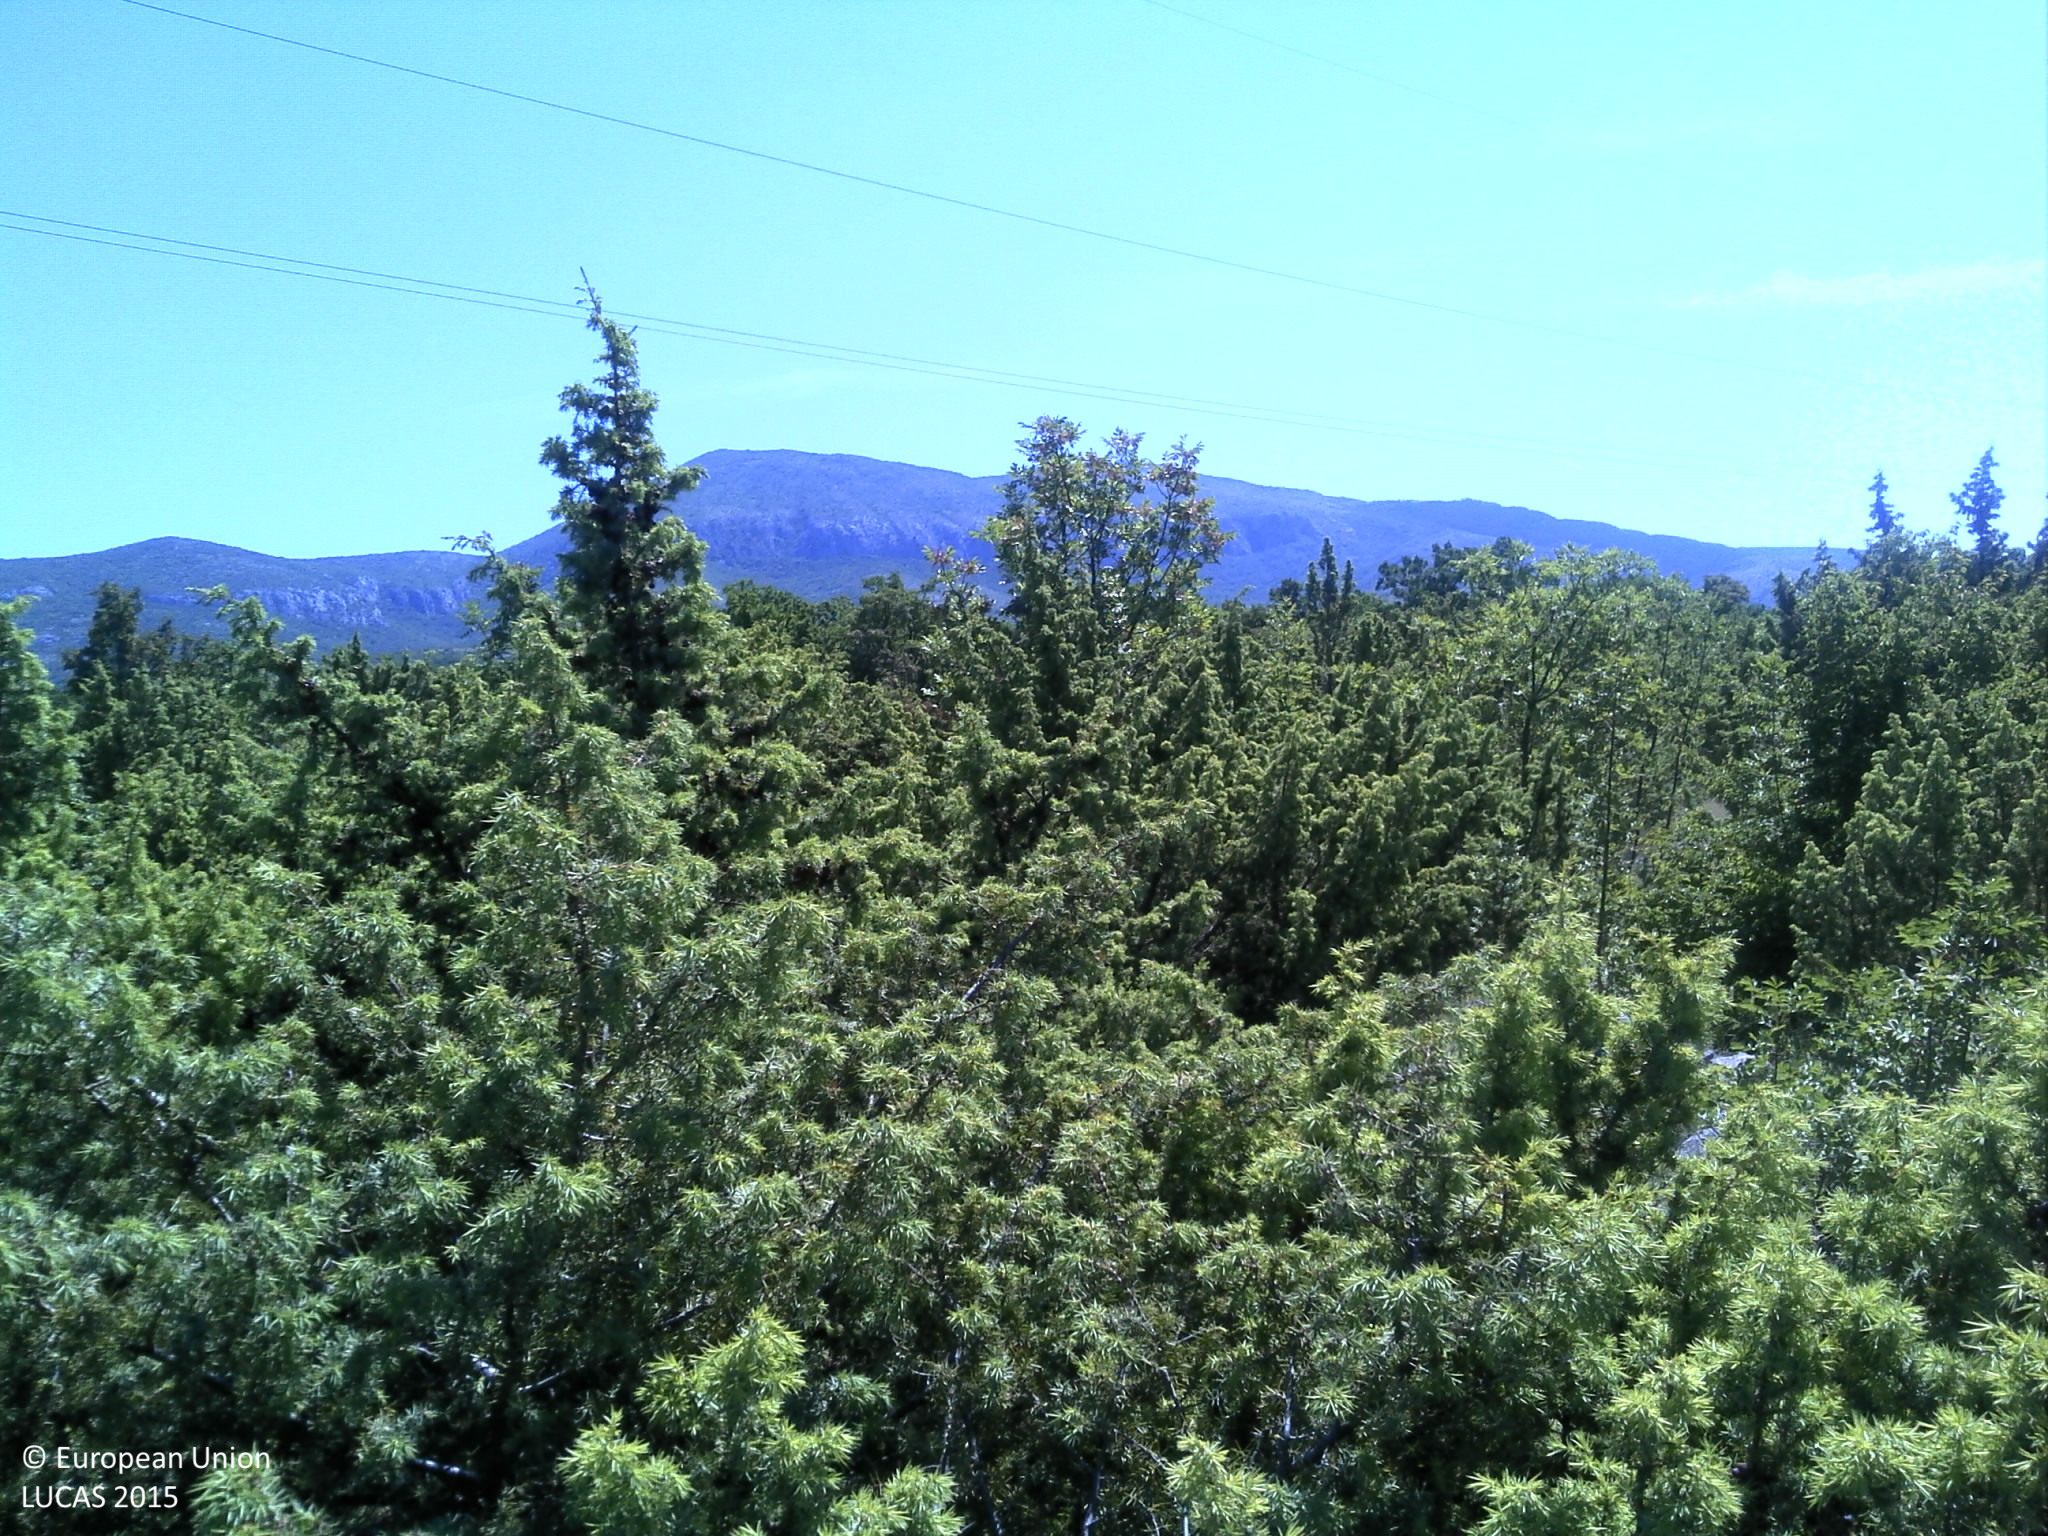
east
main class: Shrubland
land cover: Shrubland with sparse tree cover
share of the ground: 50 - 75 %
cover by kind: shrubs 50 %, herbaceous plants 35 %, unconsolidated bare surface 10 %, coniferous forest trees 5 %
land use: Semi-natural and natural areas not in use
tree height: < 5 m
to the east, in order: Shrubland with sparse tree cover; Electric lines; Shrubland with sparse tree cover; Dry stone walls; Other coniferous woodland; Dry stone walls; Grassland with sparse tree/shrub cover; Dry stone walls; Other coniferous woodland; Dry stone walls; Shrubland with sparse tree cover
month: May
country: HR
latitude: 43.9355
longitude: 16.1086
